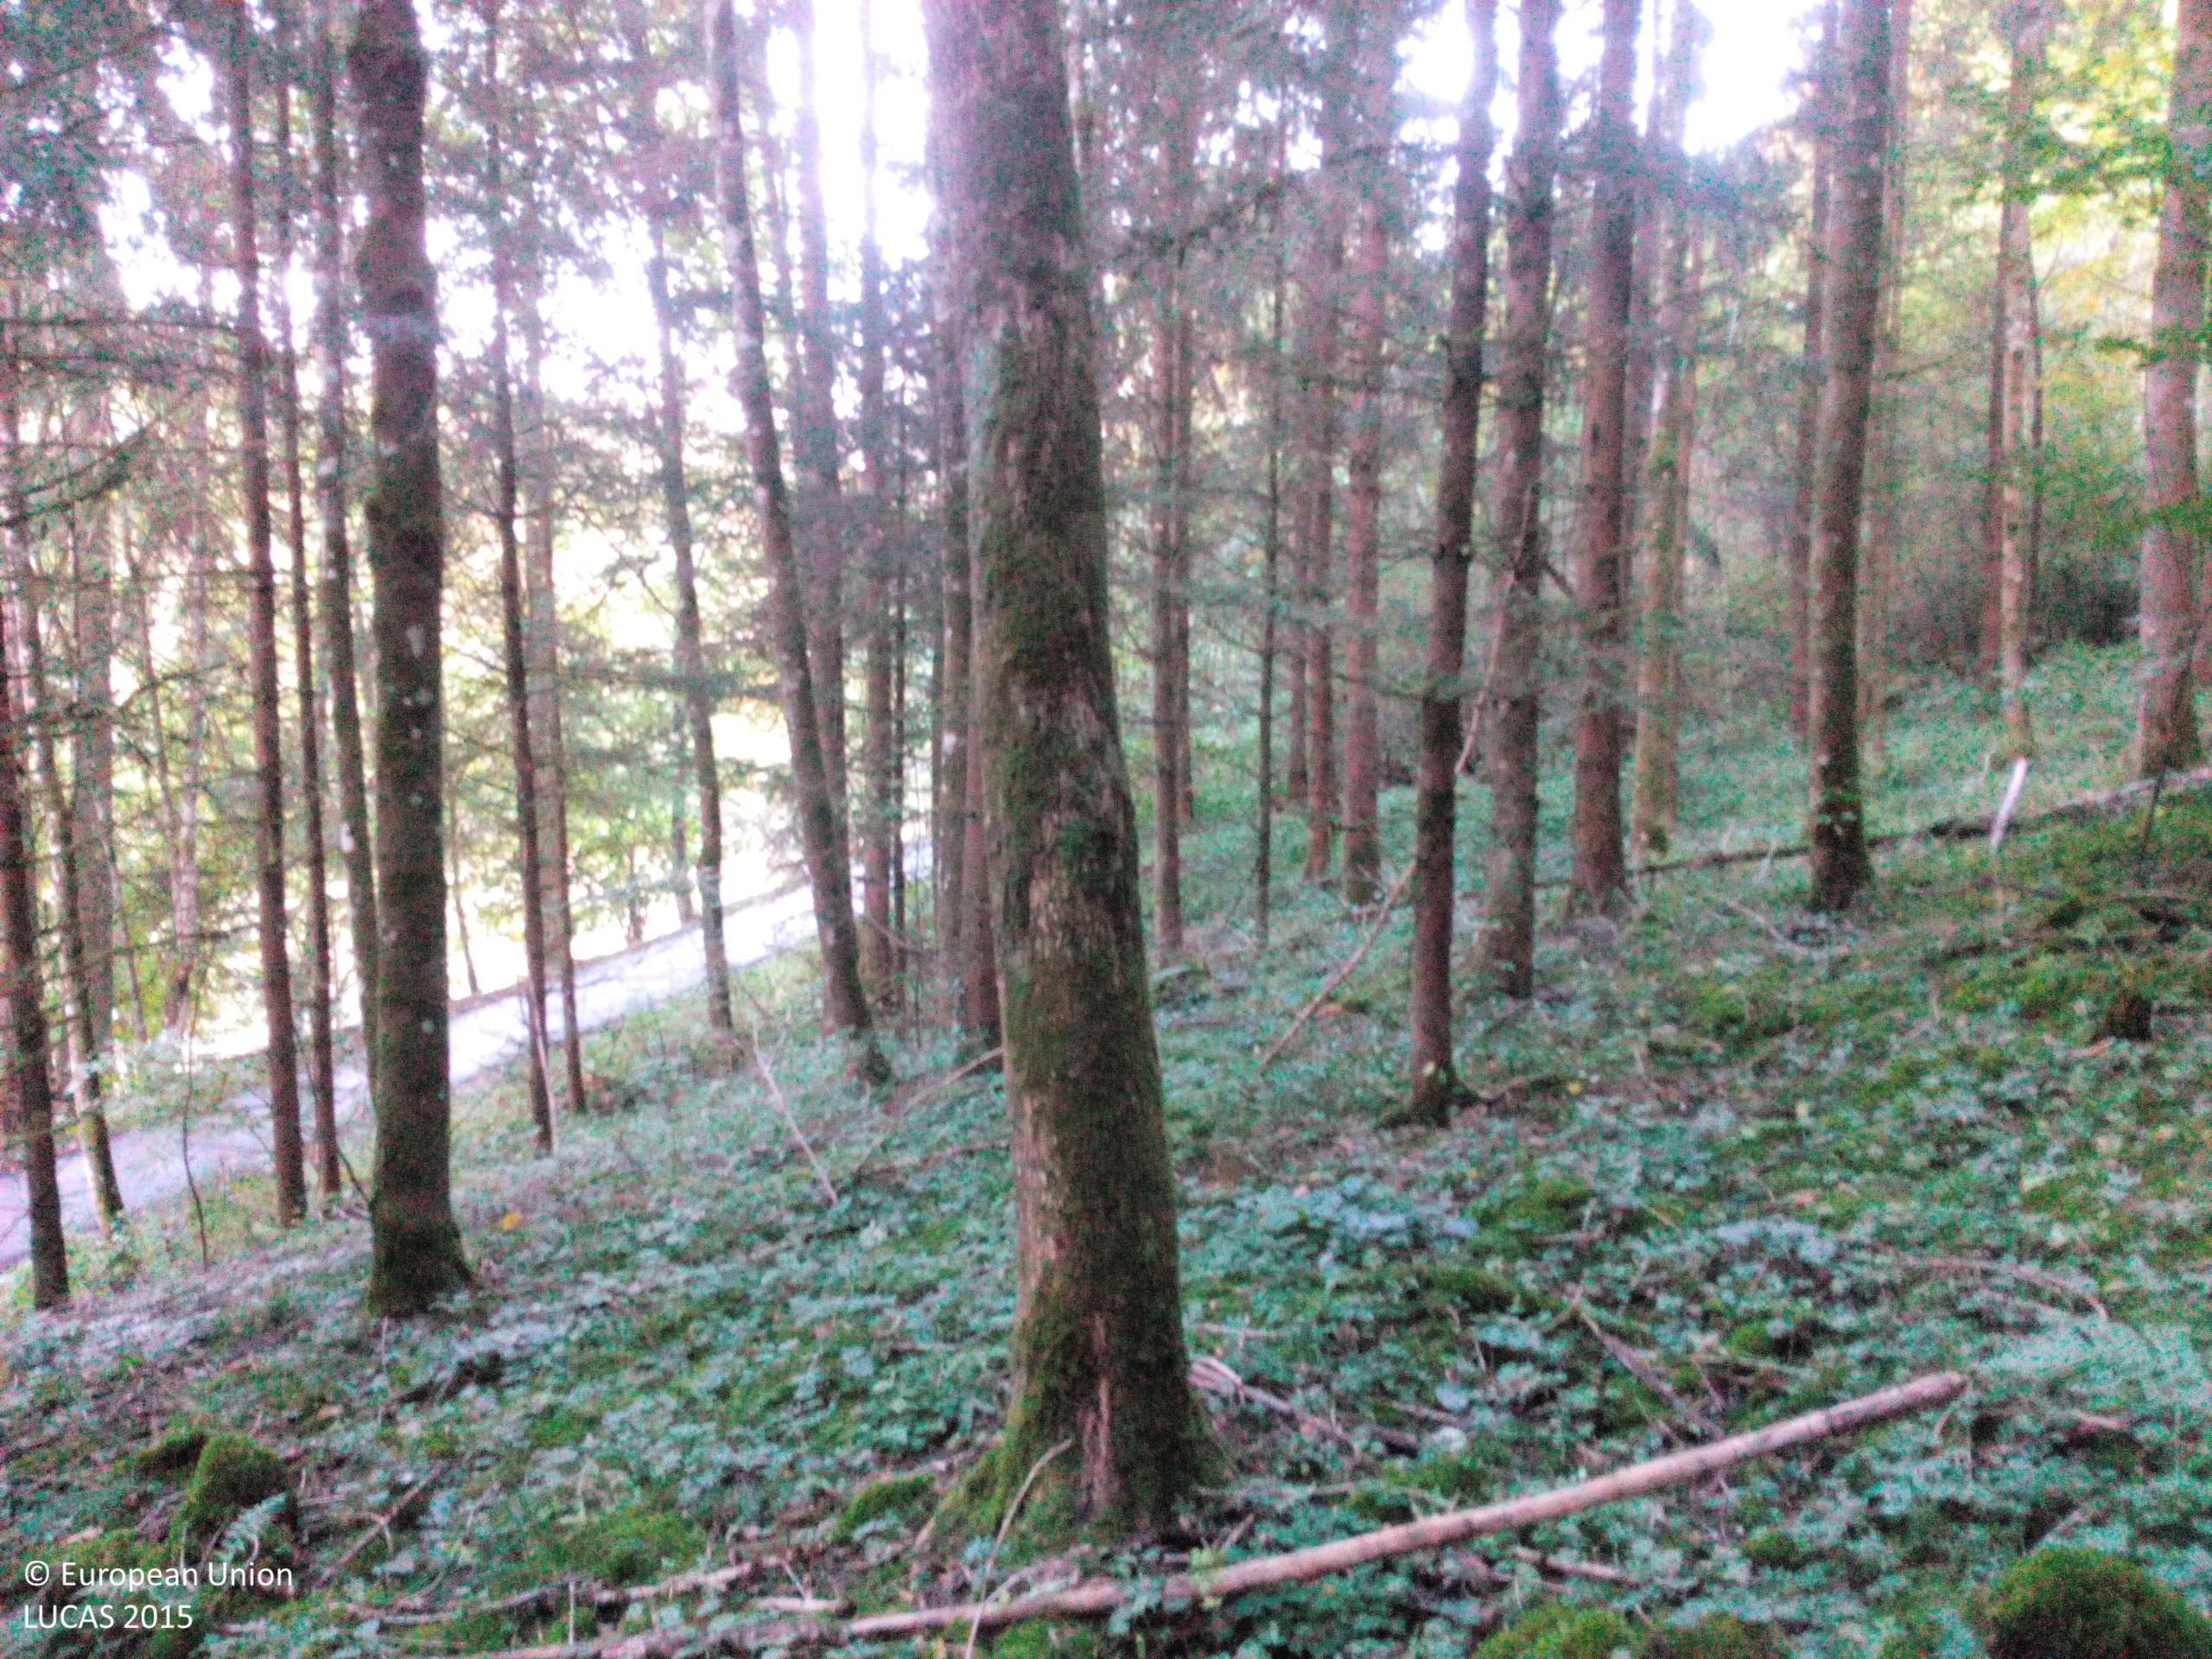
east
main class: Woodland
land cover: Other mixed woodland
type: hemiboreal forest and nemoral coniferous forest and mixed broadleaved-coniferous forest
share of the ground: > 75 %
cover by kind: broadleaved forest trees 60 %, coniferous forest trees 30 %, herbaceous plants 5 %, consolidated bare surface 5 %
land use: Forestry
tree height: > 5 m
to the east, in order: Other mixed woodland; Broadleaved woodland; Paved roads, cycling and walking lanes; Fences; Broadleaved woodland
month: September
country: DE
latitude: 48.5397
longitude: 8.6868
